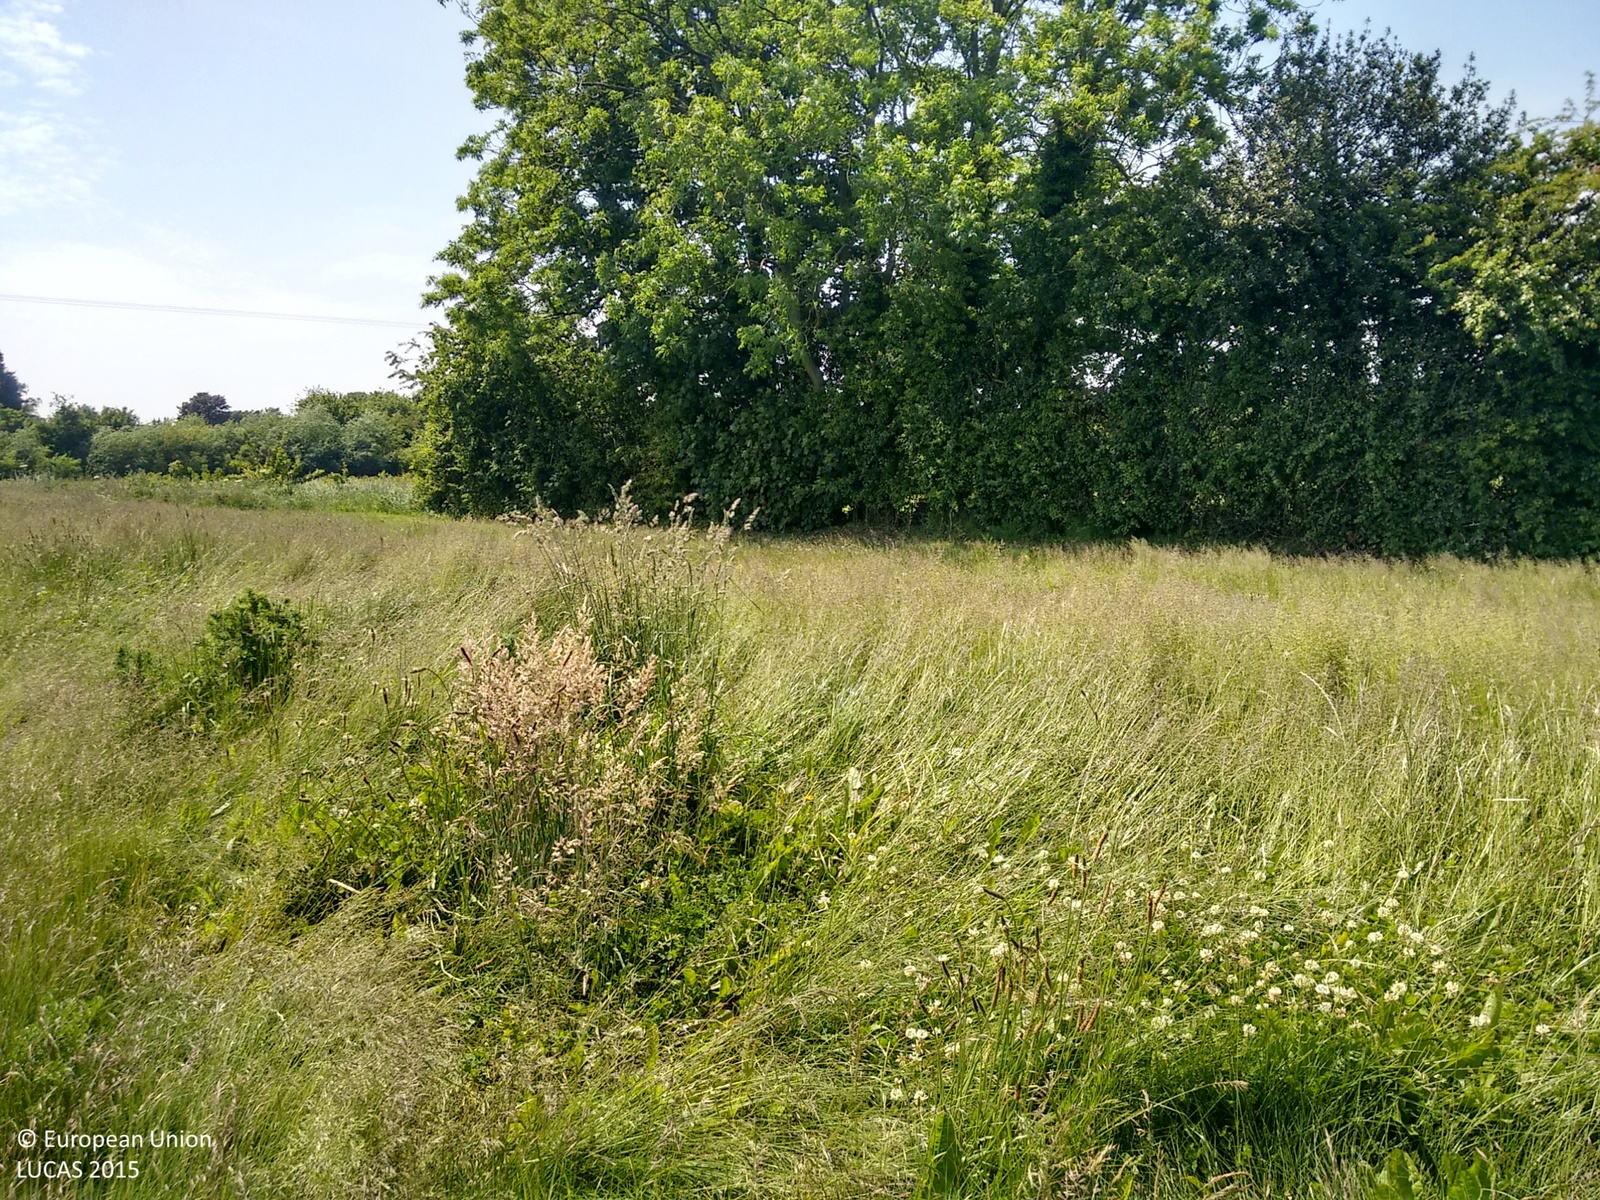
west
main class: Cropland
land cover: Common wheat
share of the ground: > 75 %
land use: Agriculture (excluding fallow land and kitchen gardens)
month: June
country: GB
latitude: 53.8320
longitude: -1.1213
